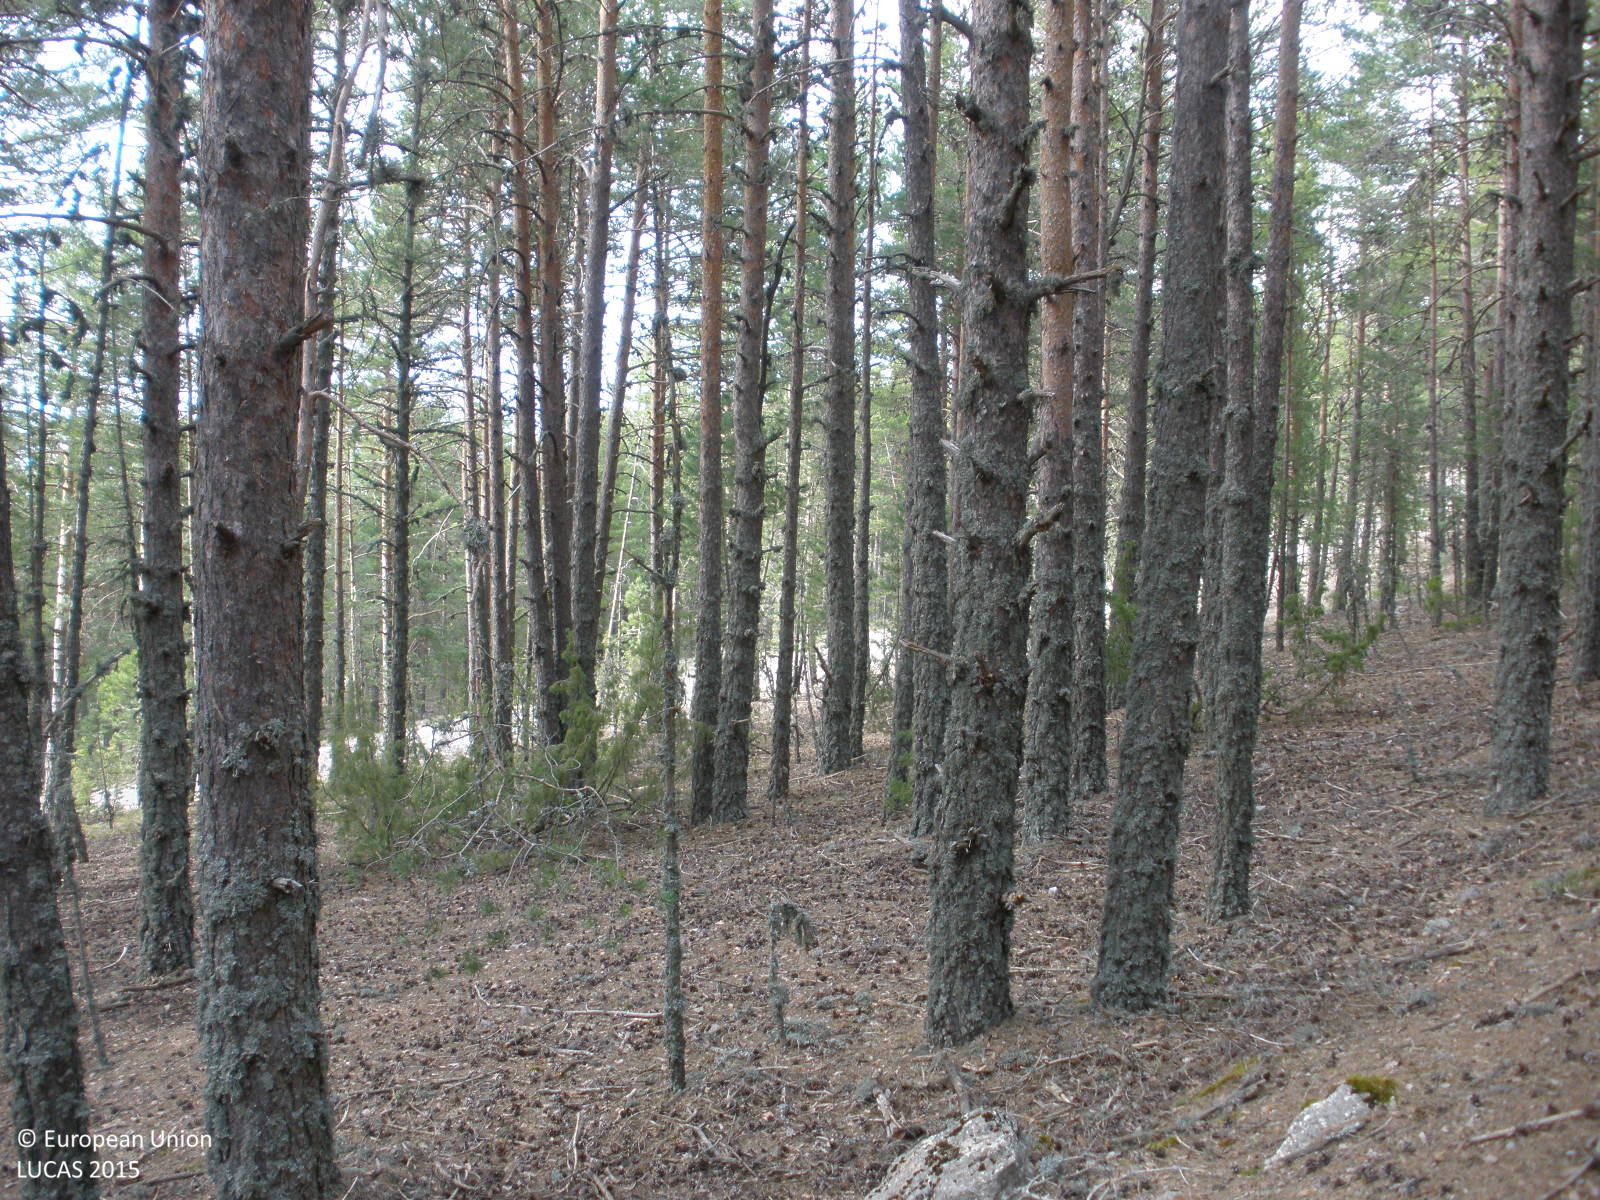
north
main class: Woodland
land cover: Pine dominated coniferous woodland
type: coniferous forest of the mediterranean region
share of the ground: > 75 %
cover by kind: coniferous forest trees 90 %, consolidated bare surface 10 %
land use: Semi-natural and natural areas not in use
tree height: > 5 m
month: April
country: ES
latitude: 40.1183
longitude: -1.0255
